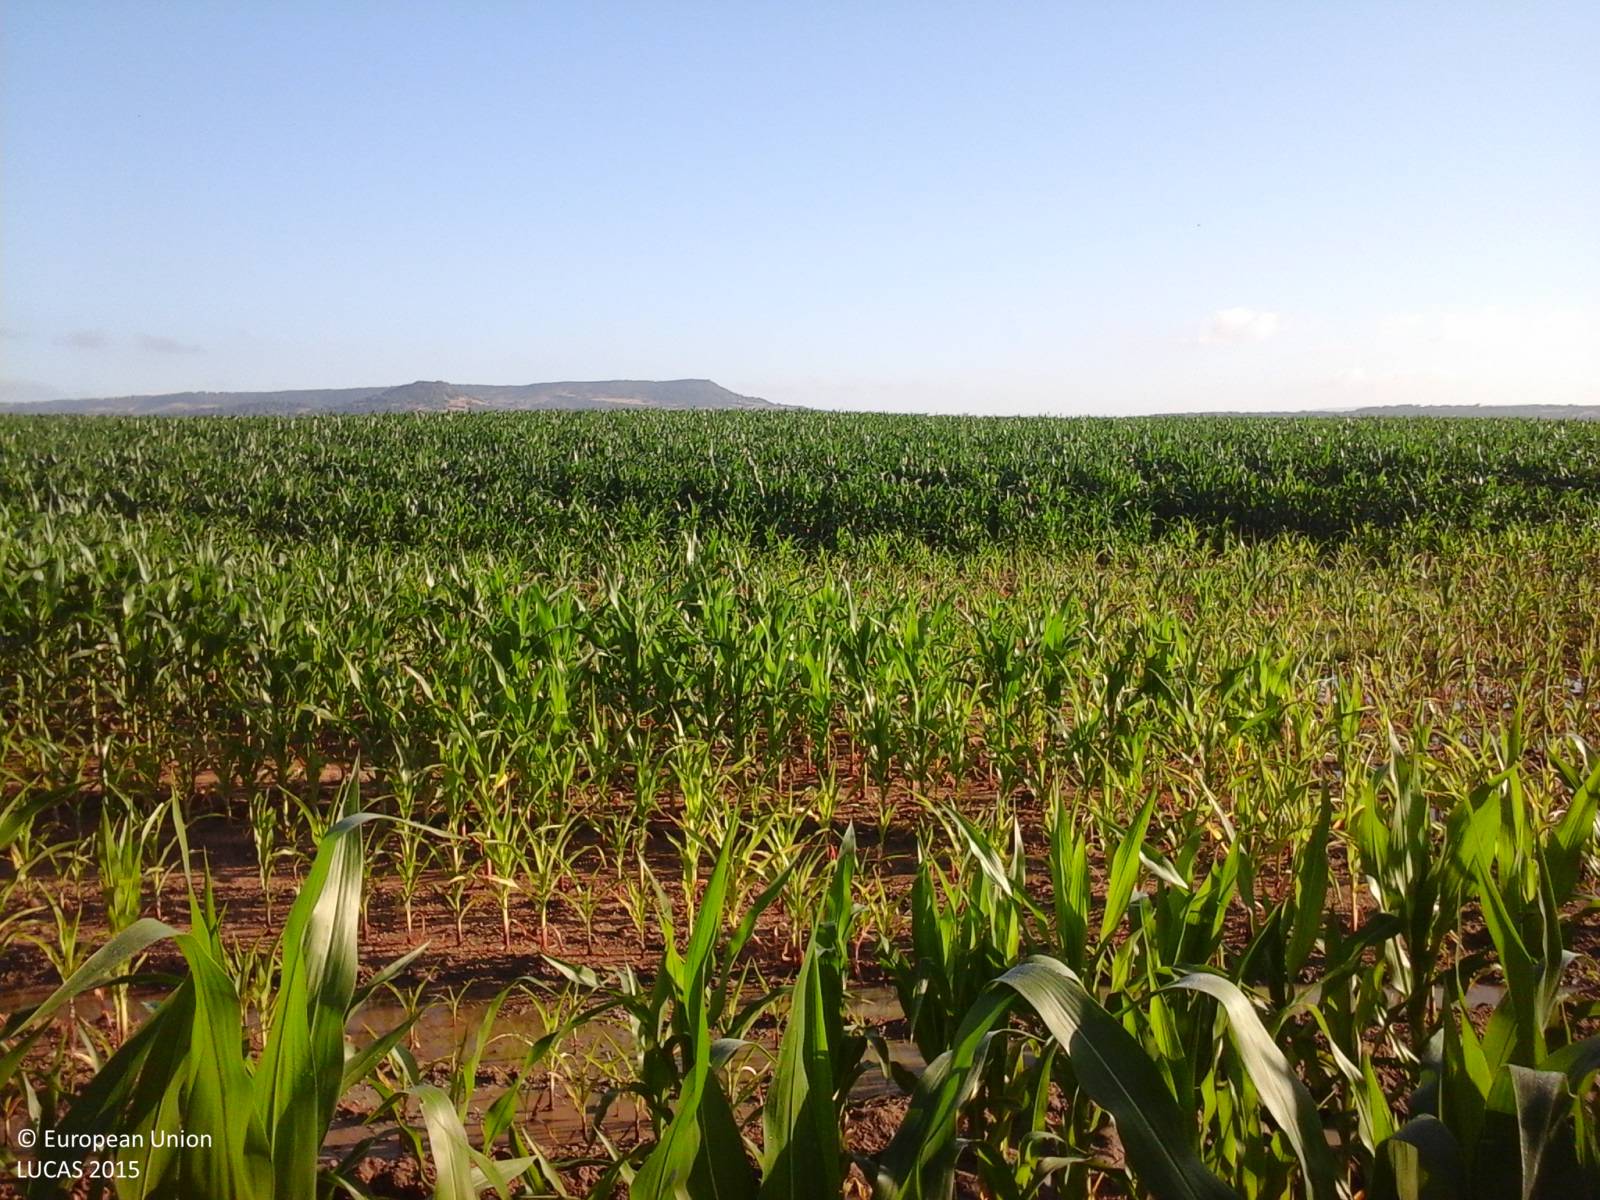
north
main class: Cropland
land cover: Maize
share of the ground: > 75 %
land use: Agriculture (excluding fallow land and kitchen gardens)
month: July
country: IT
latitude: 40.6227
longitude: 8.8590
